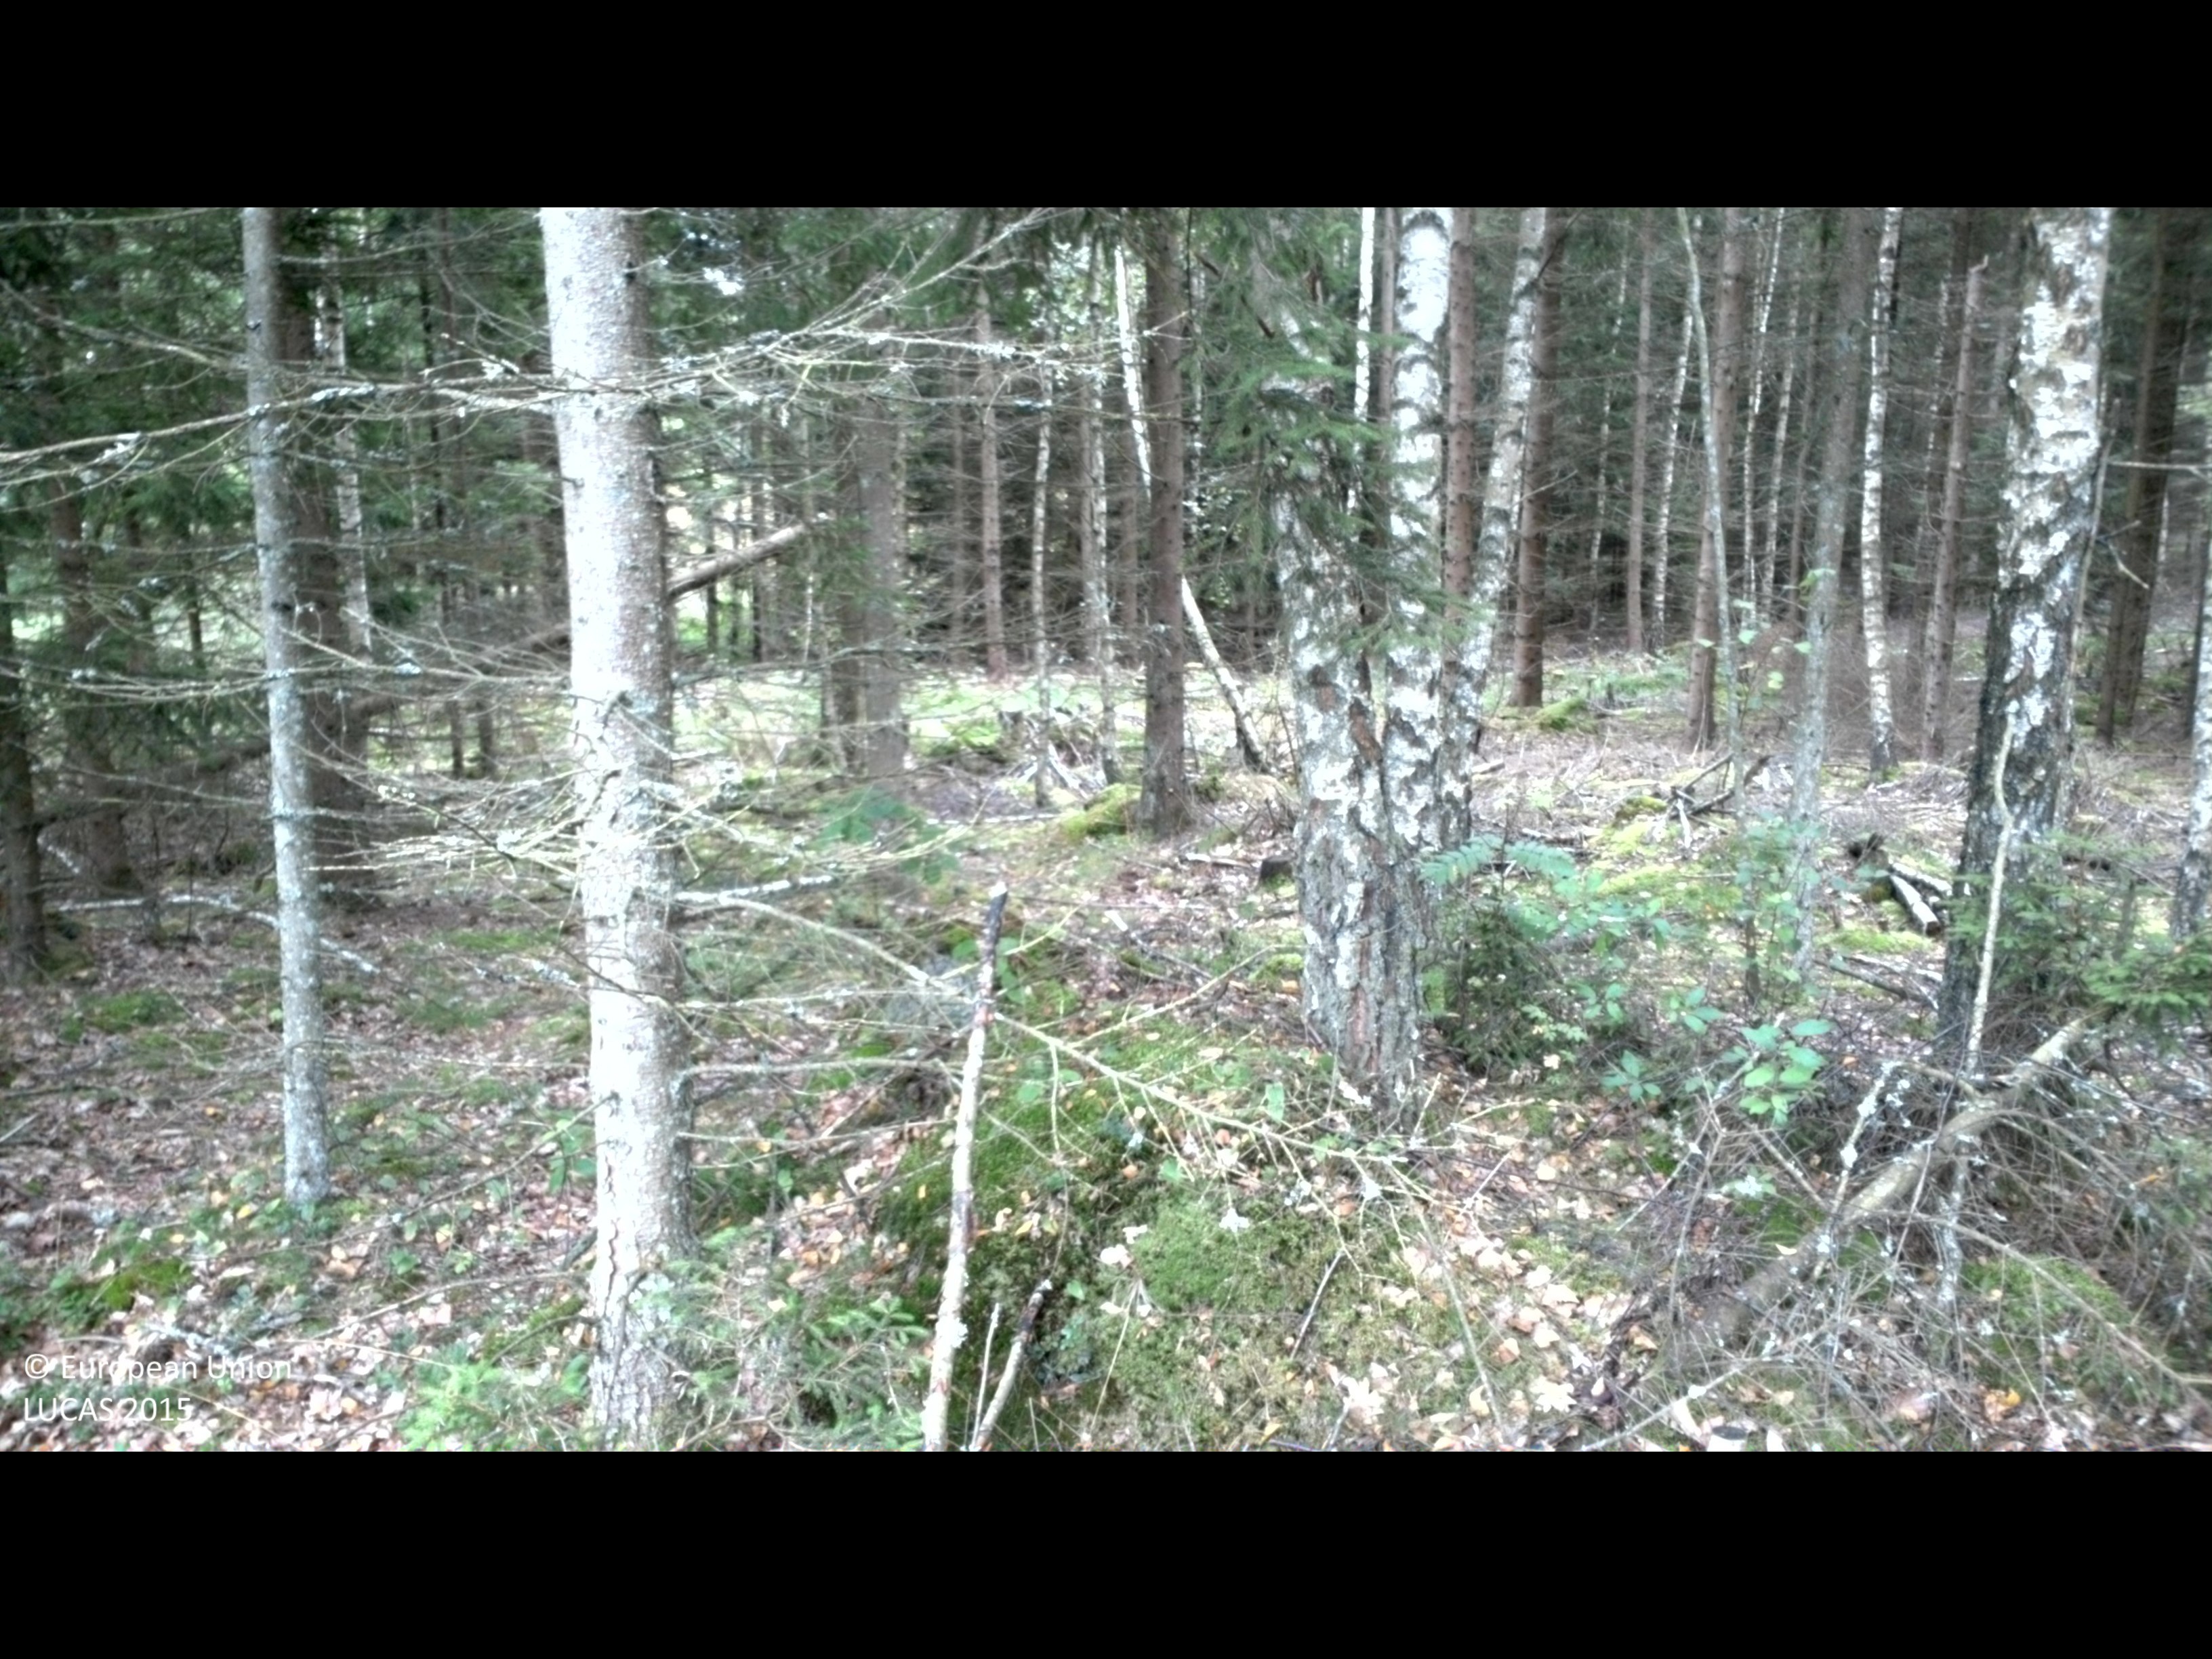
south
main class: Woodland
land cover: Spruce dominated mixed woodland
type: boreal forest
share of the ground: 50 - 75 %
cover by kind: coniferous forest trees 50 %, broadleaved forest trees 20 %, shrubs 15 %, lichens and mosses 15 %
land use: Forestry
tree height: > 5 m
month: August
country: SE
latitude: 56.3334
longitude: 14.2514
